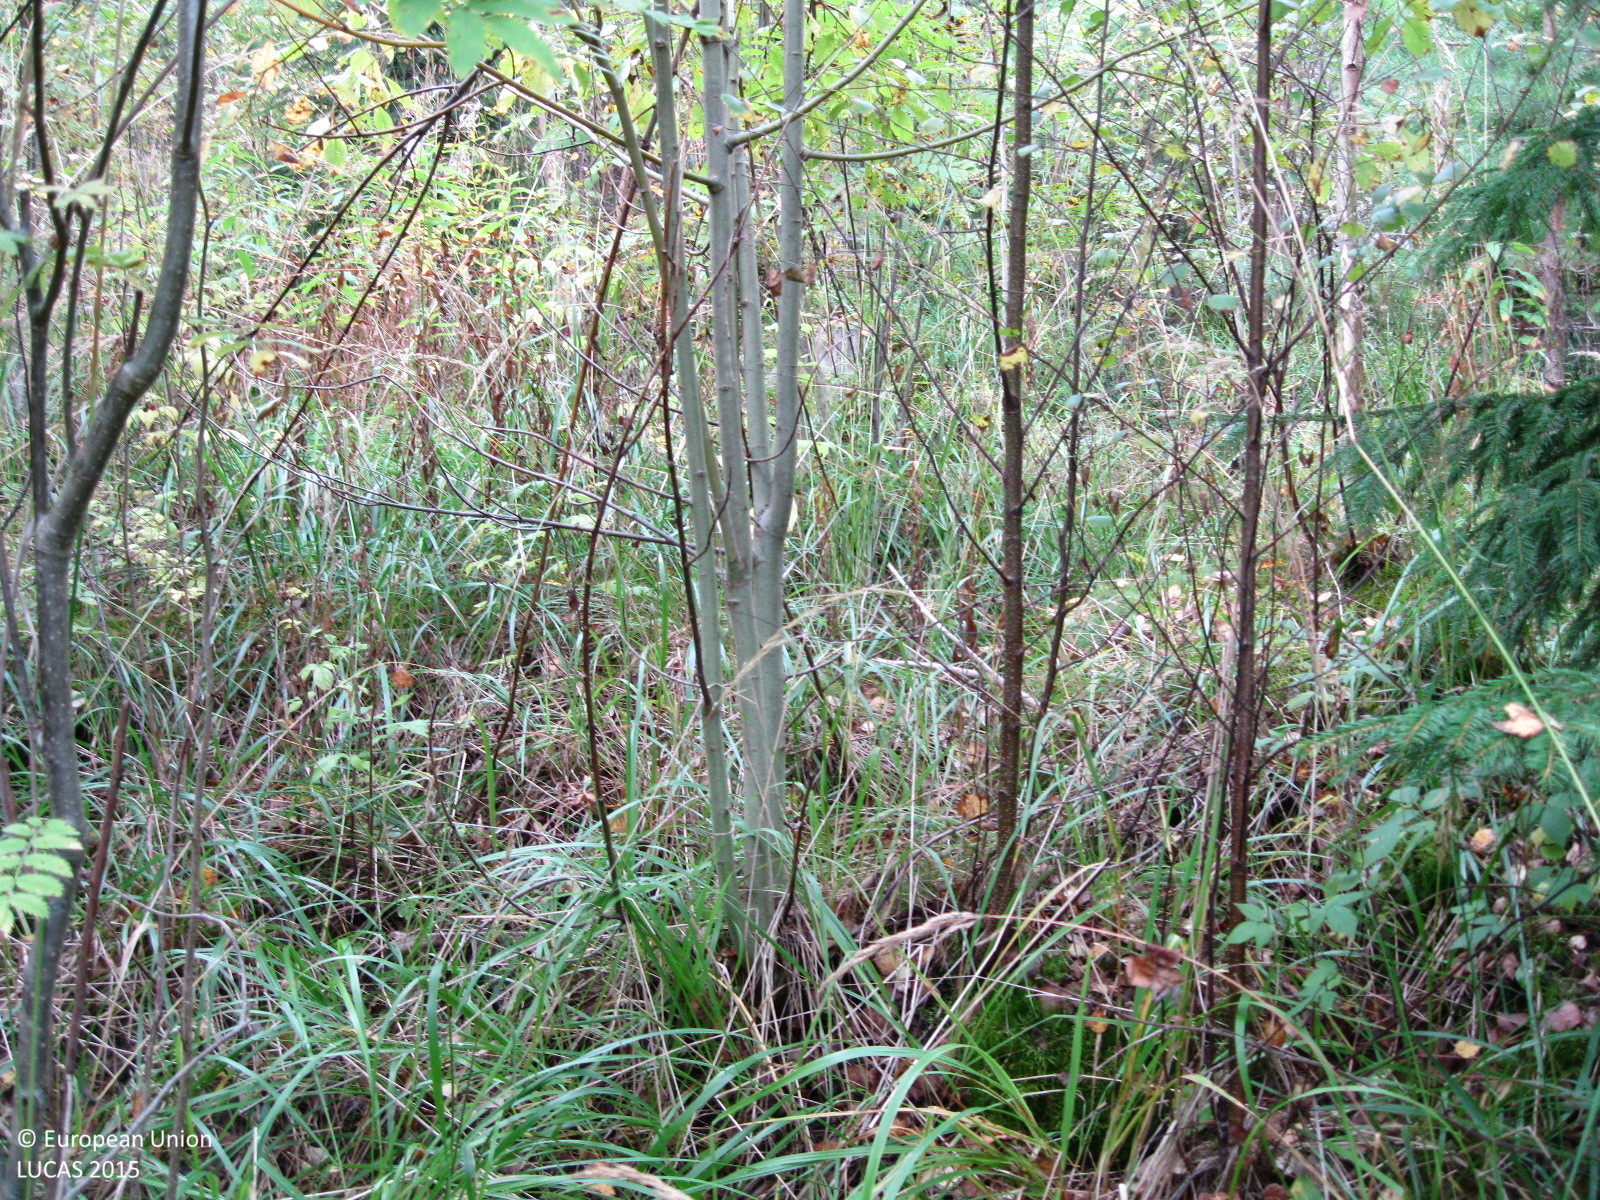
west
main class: Woodland
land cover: Broadleaved woodland
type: boreal forest
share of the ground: > 75 %
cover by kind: broadleaved forest trees 80 %, herbaceous plants 10 %, coniferous forest trees 5 %, shrubs 5 %
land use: Forestry
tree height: > 5 m
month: September
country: FI
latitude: 60.7973
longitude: 24.9040
